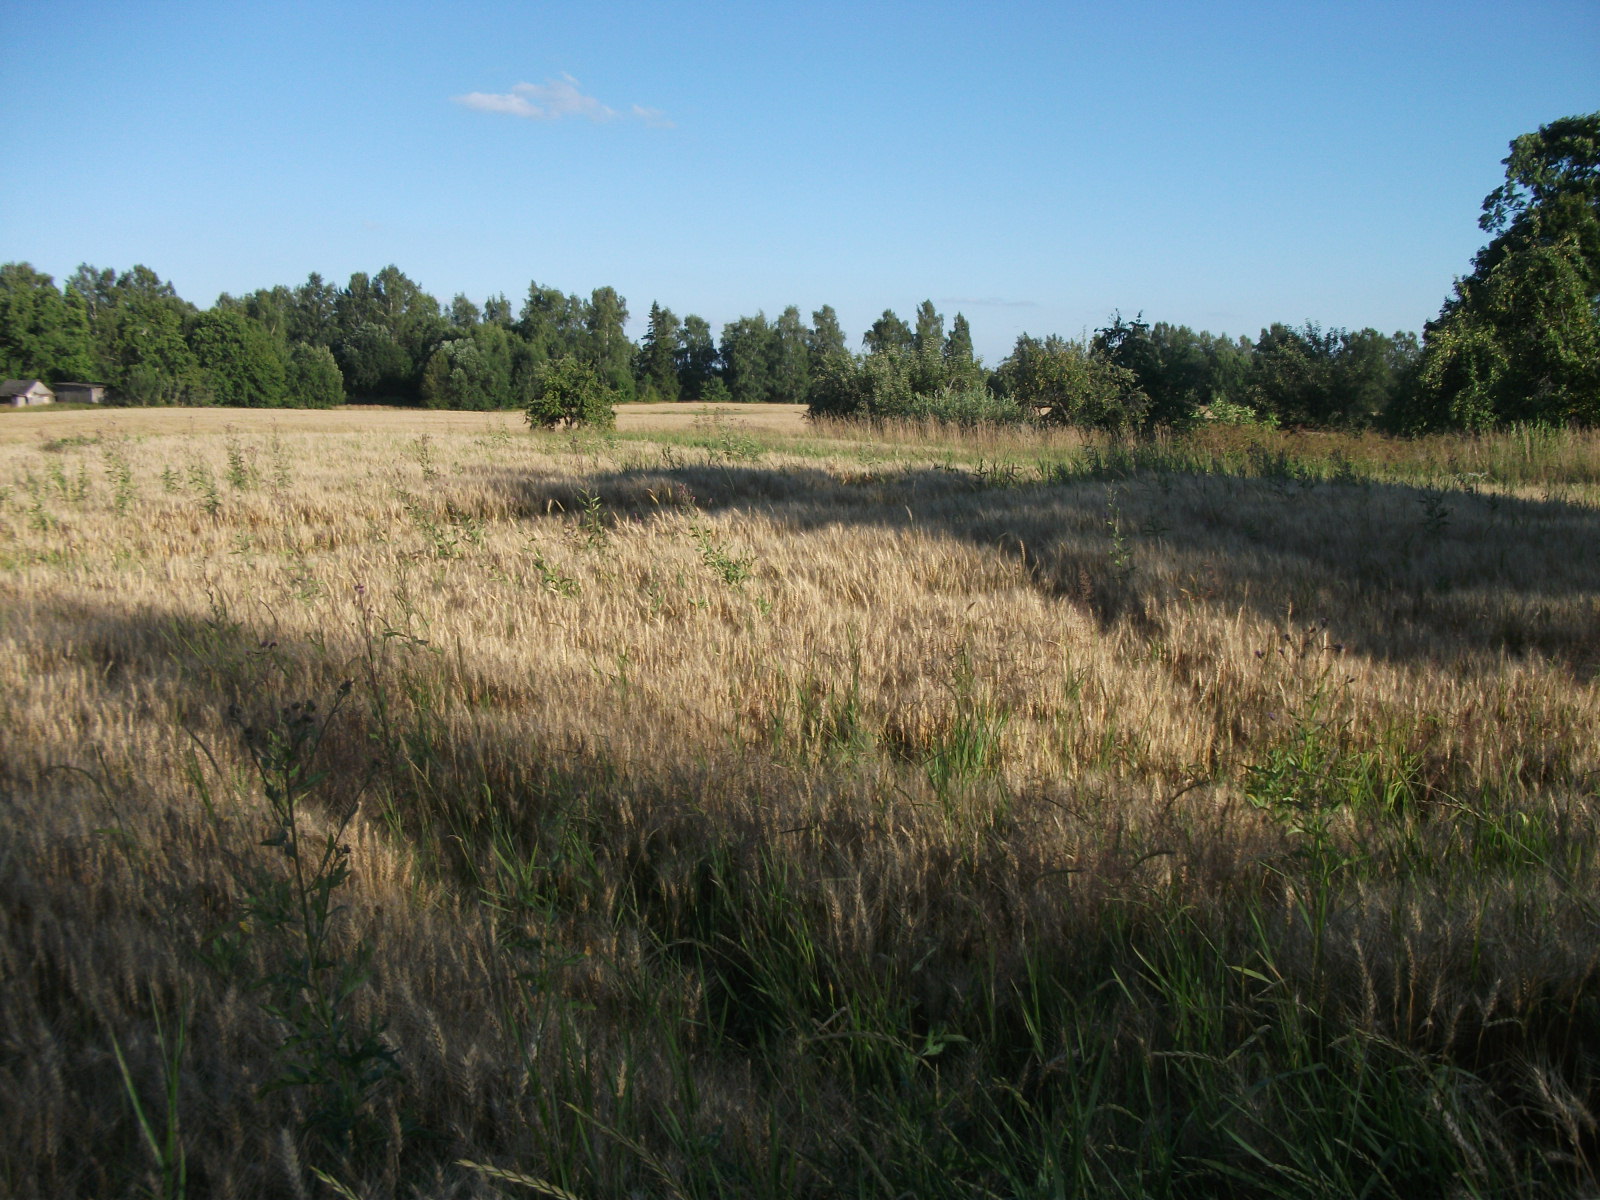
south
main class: Cropland
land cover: Common wheat
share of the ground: > 75 %
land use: Agriculture (excluding fallow land and kitchen gardens)
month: August
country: LV
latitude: 57.0573
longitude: 26.5182
